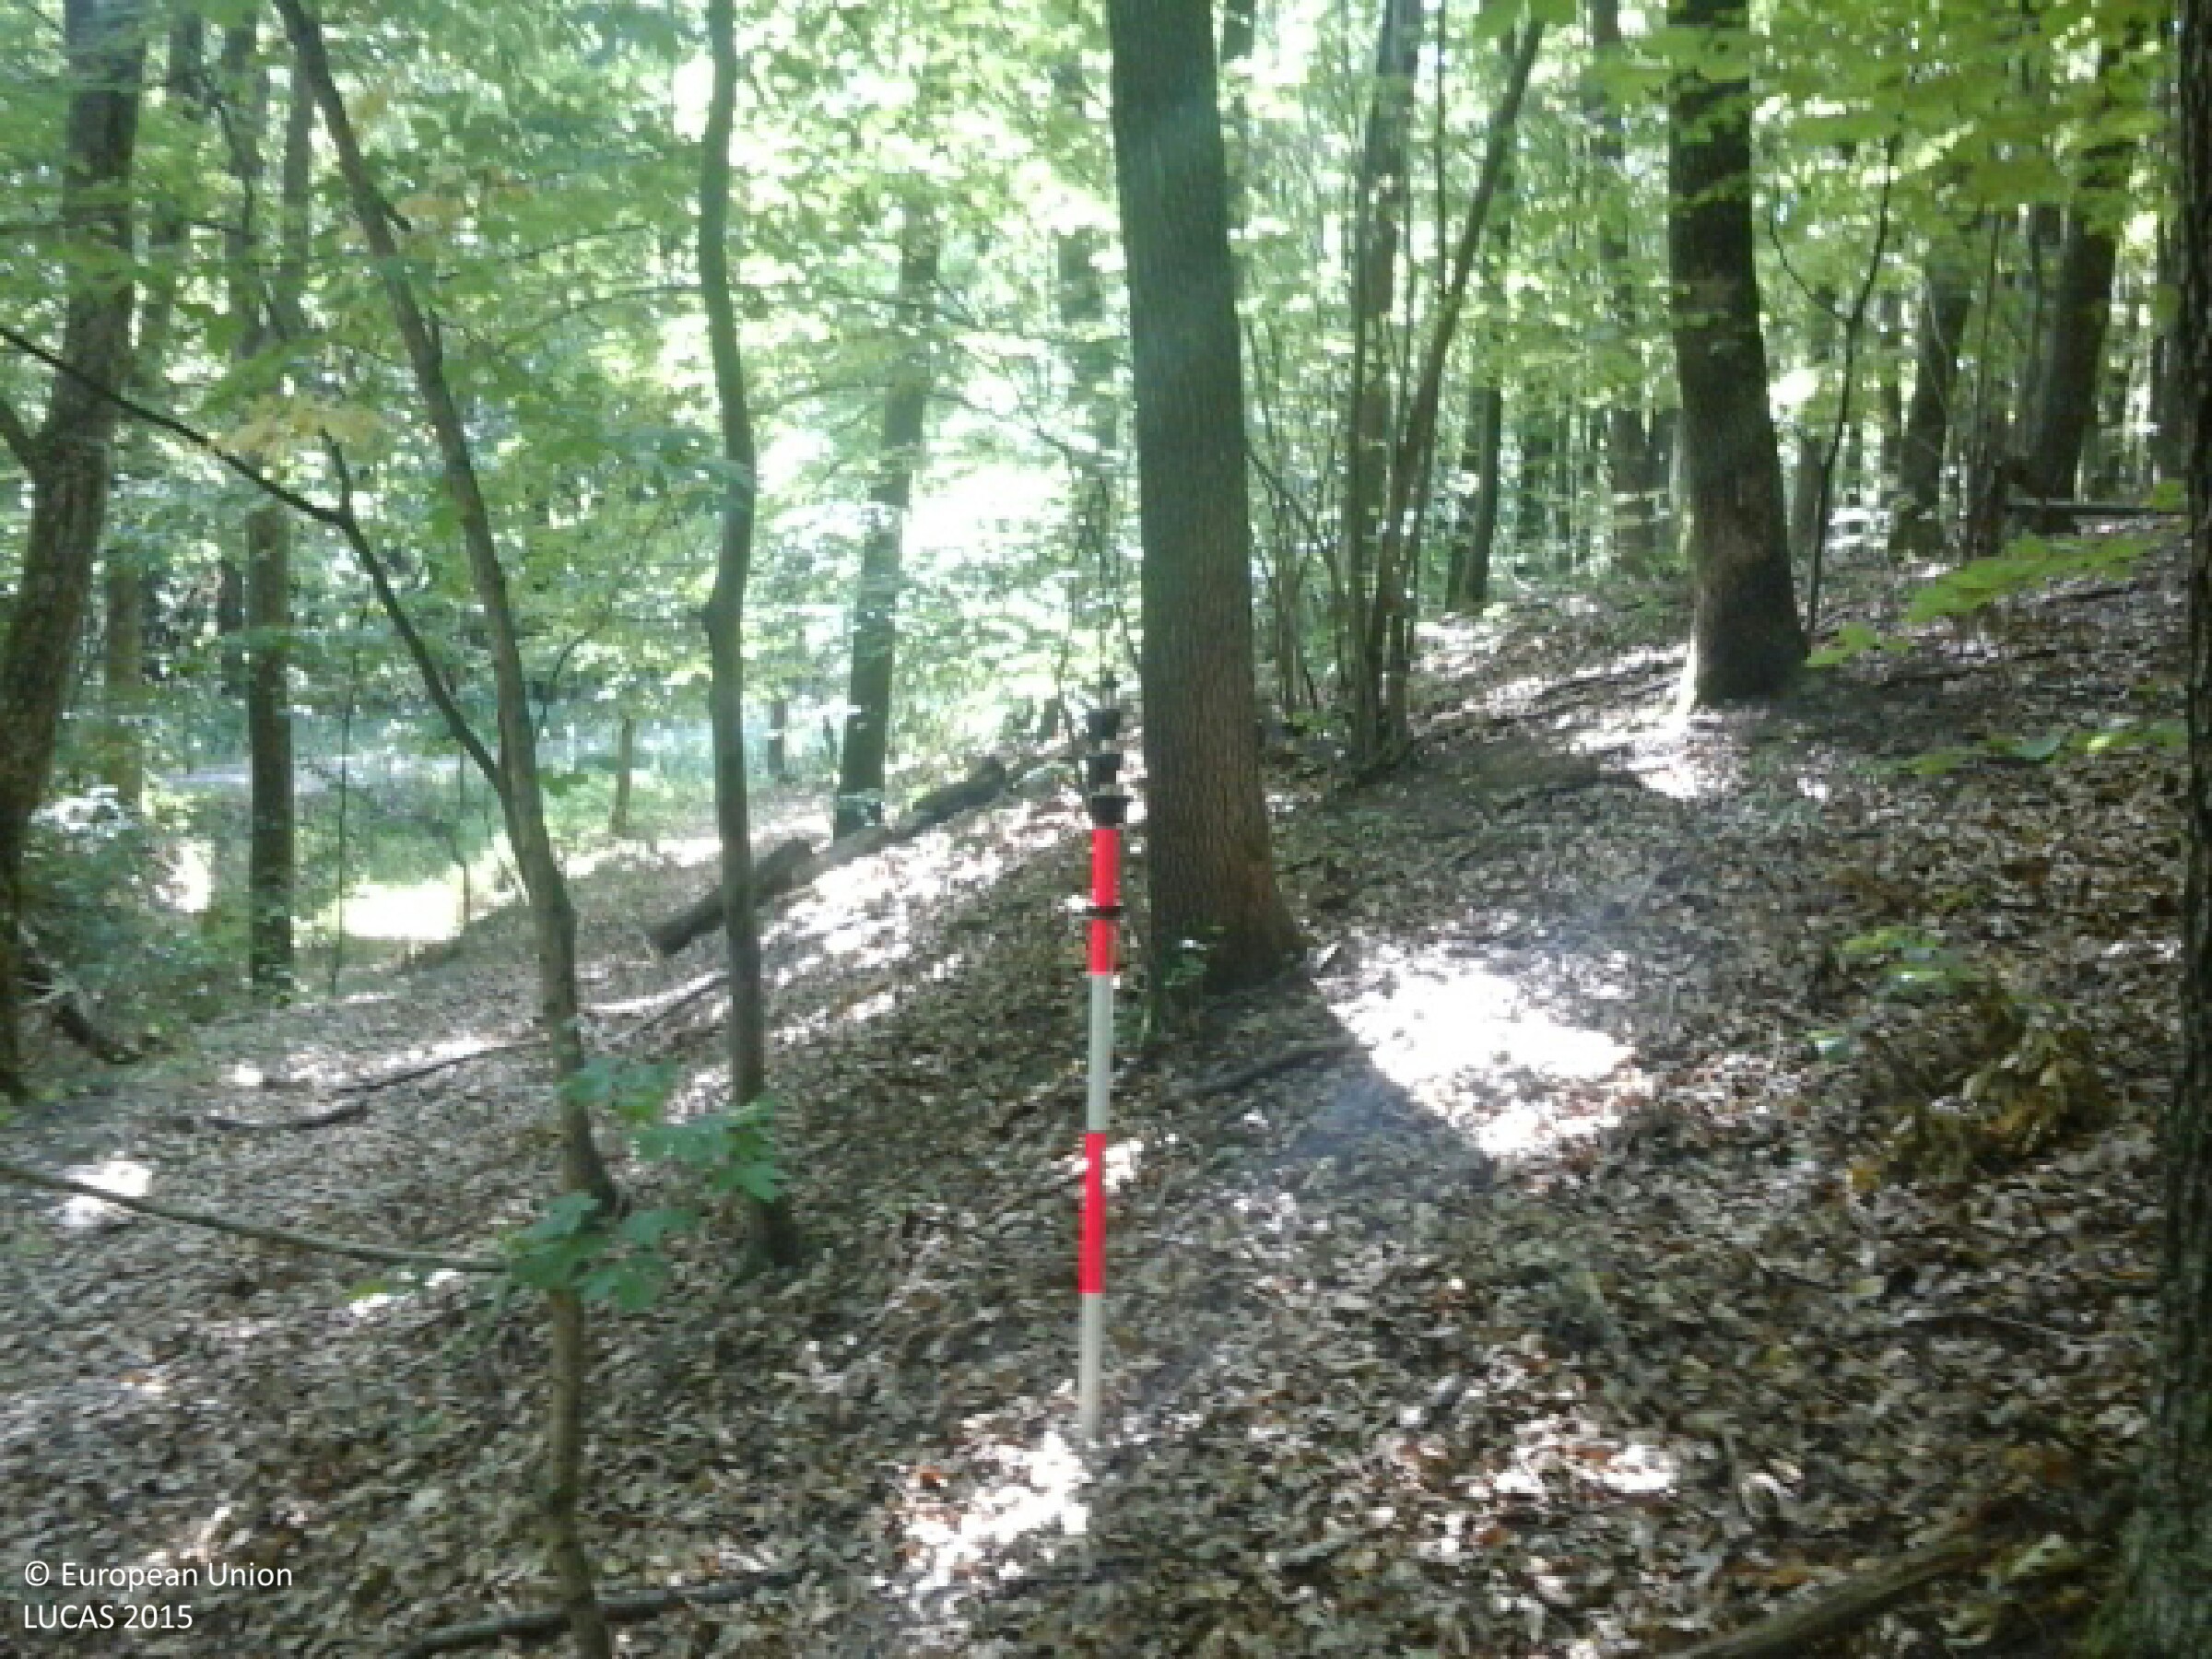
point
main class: Woodland
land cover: Broadleaved woodland
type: mesophytic deciduous forest
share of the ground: > 75 %
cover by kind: broadleaved forest trees 100 %
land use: Forestry
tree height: > 5 m
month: July
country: HU
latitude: 48.3789
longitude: 21.5370
